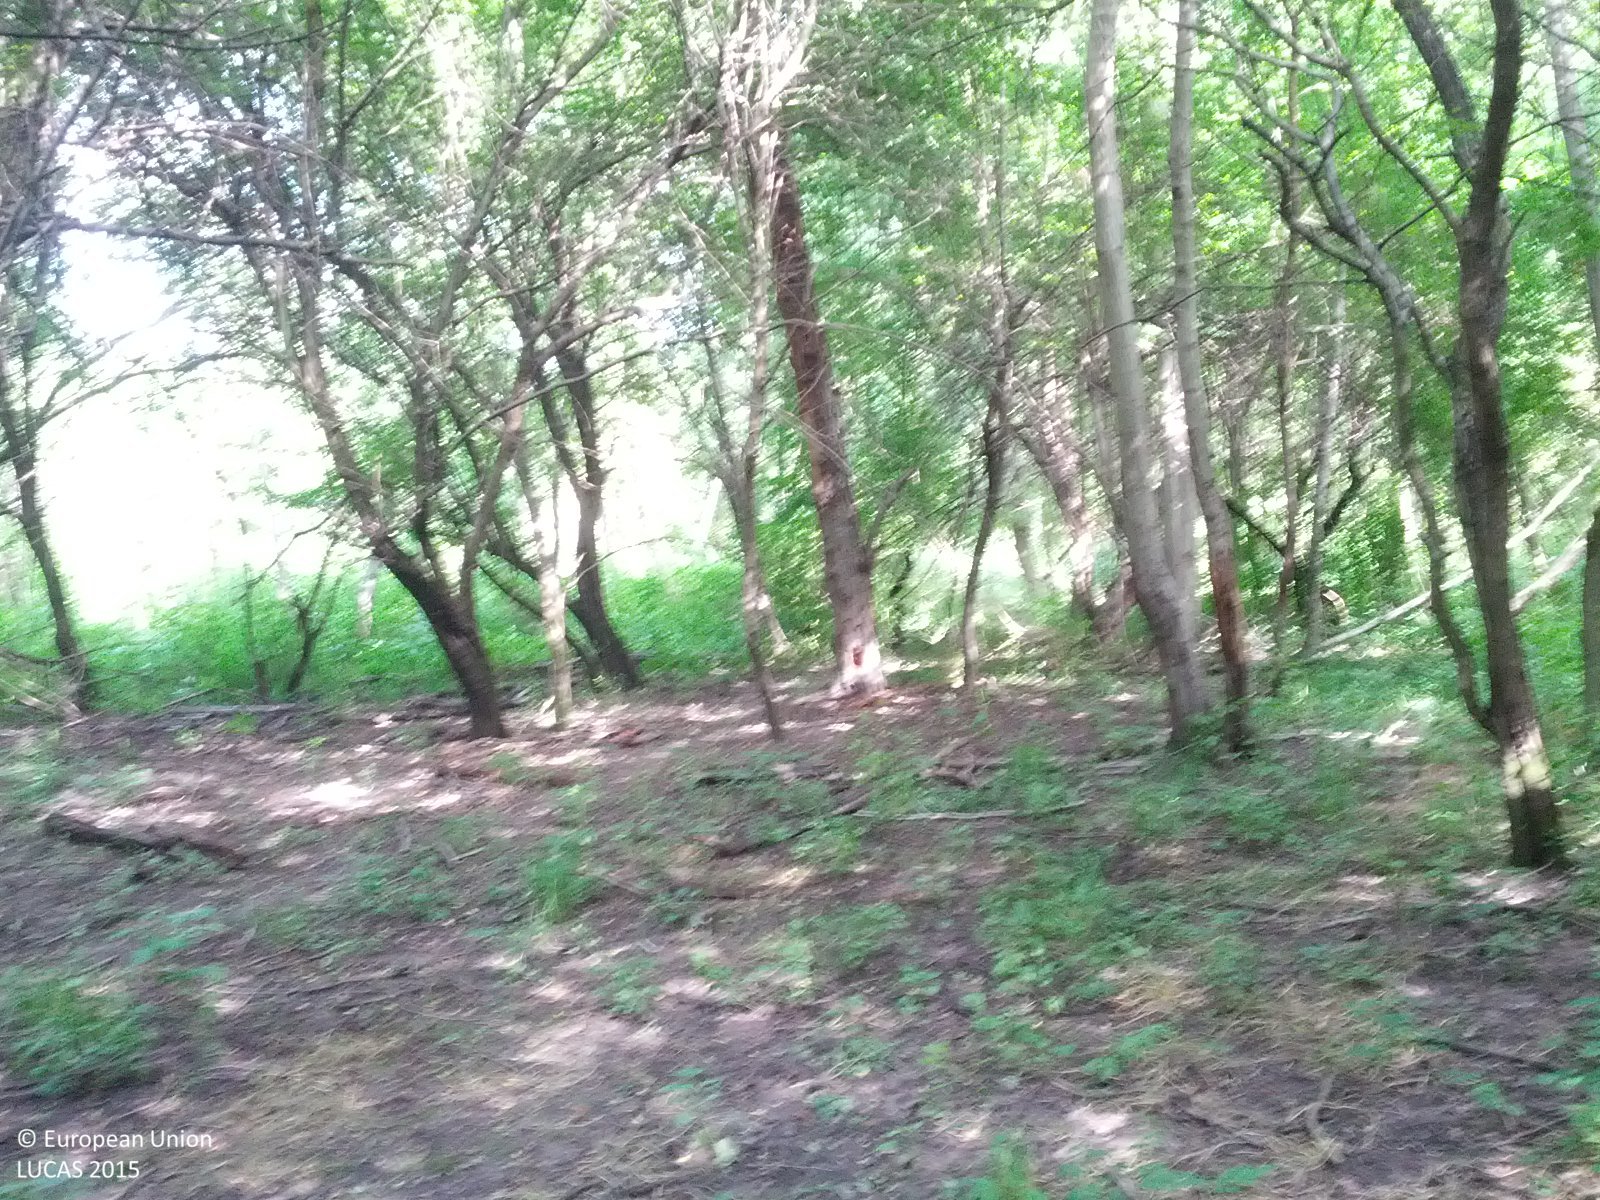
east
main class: Woodland
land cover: Broadleaved woodland
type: floodplain forest
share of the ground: > 75 %
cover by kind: broadleaved forest trees 75 %, herbaceous plants 25 %
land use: Semi-natural and natural areas not in use
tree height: > 5 m
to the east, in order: Broadleaved woodland
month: July
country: AT
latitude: 48.1290
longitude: 16.6837
